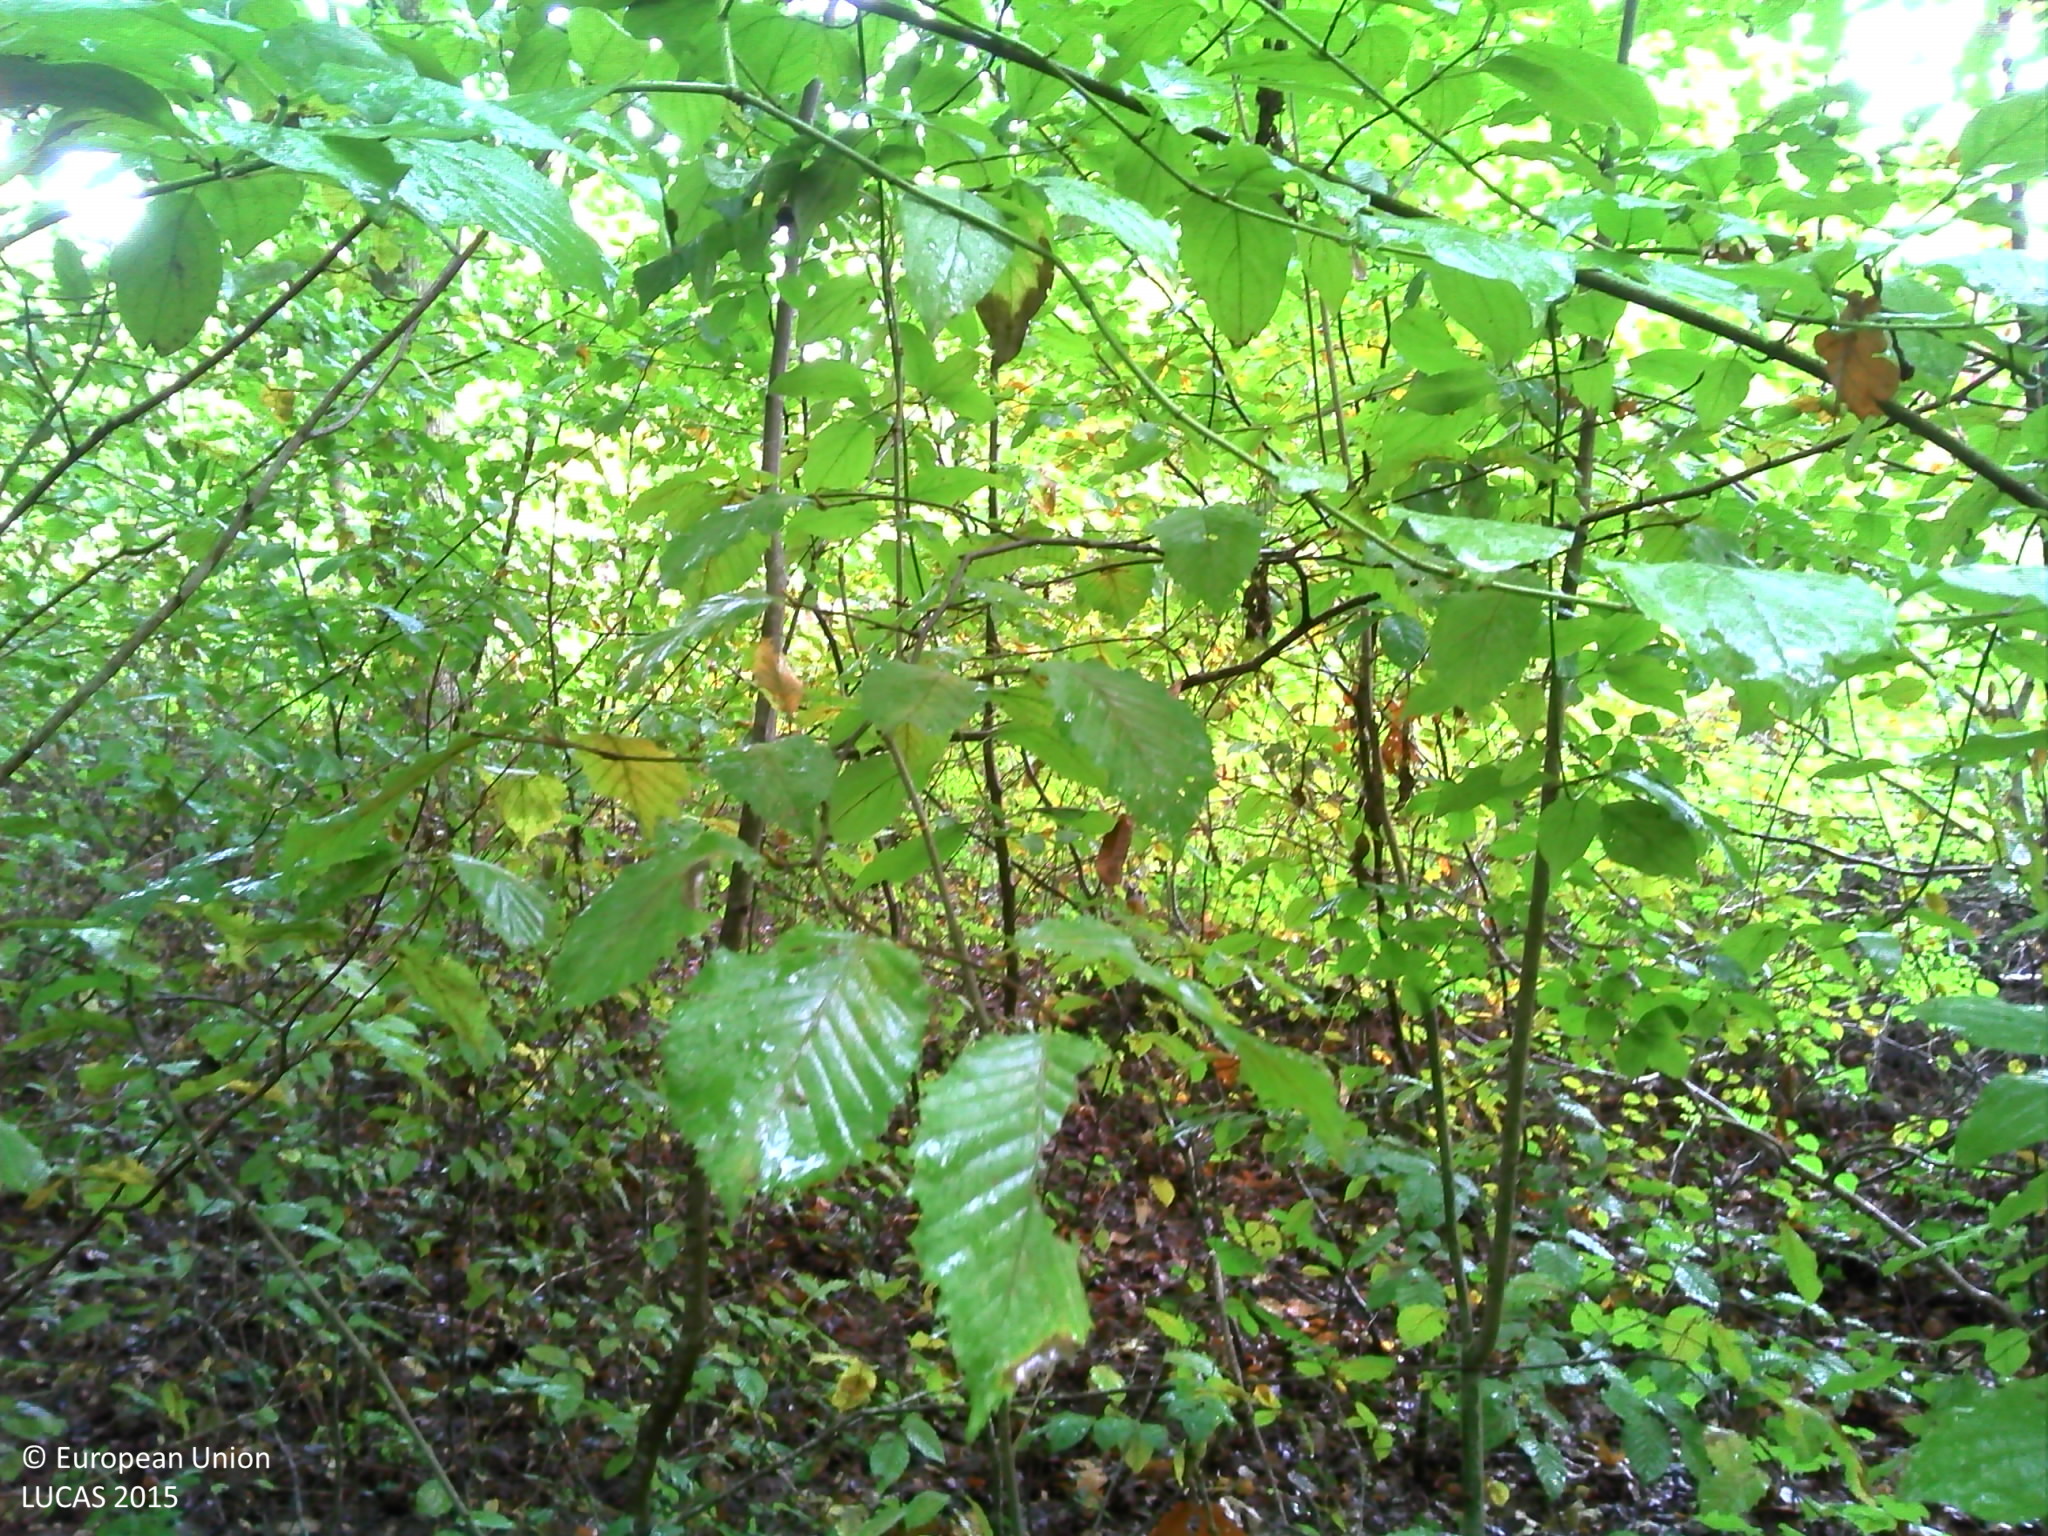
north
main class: Woodland
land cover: Broadleaved woodland
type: mesophytic deciduous forest
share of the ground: > 75 %
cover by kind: broadleaved forest trees 100 %
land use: Forestry
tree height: > 5 m
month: October
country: FR
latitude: 48.2537
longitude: 4.2458
